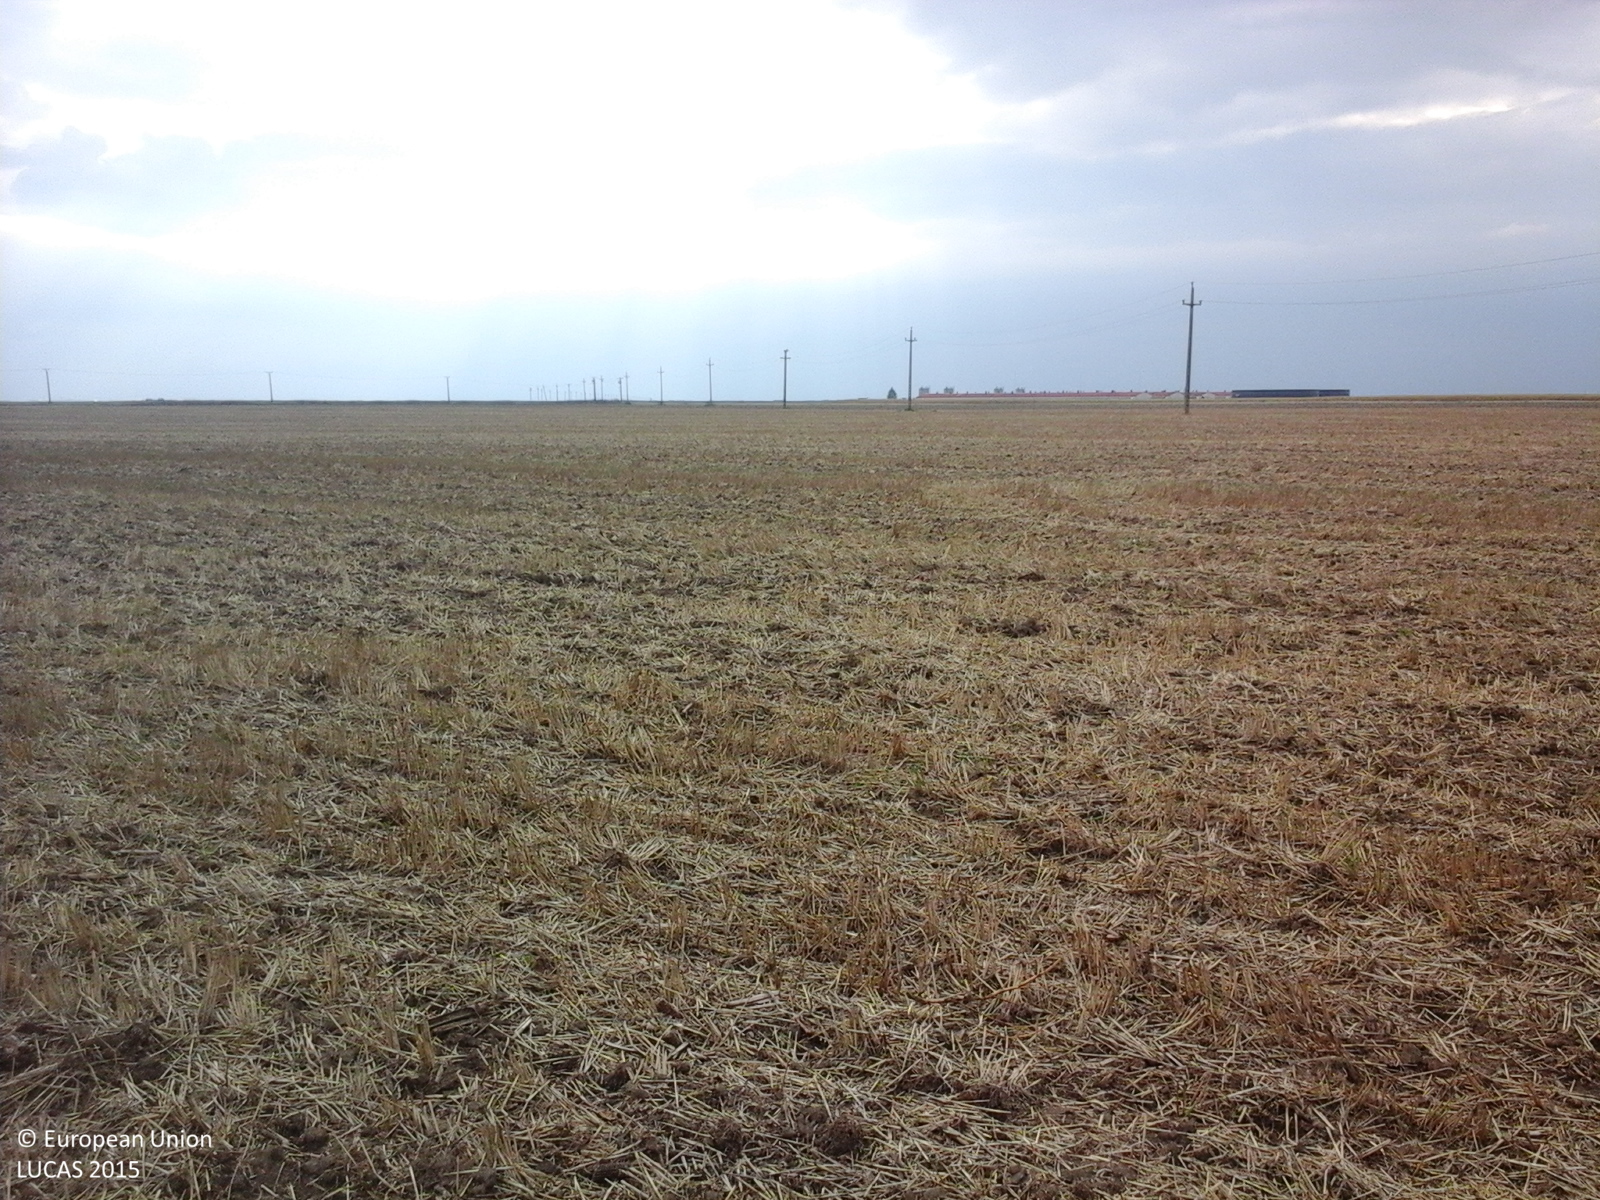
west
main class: Cropland
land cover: Common wheat
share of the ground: 50 - 75 %
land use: Agriculture (excluding fallow land and kitchen gardens)
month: August
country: RO
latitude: 46.0070
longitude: 20.5757
